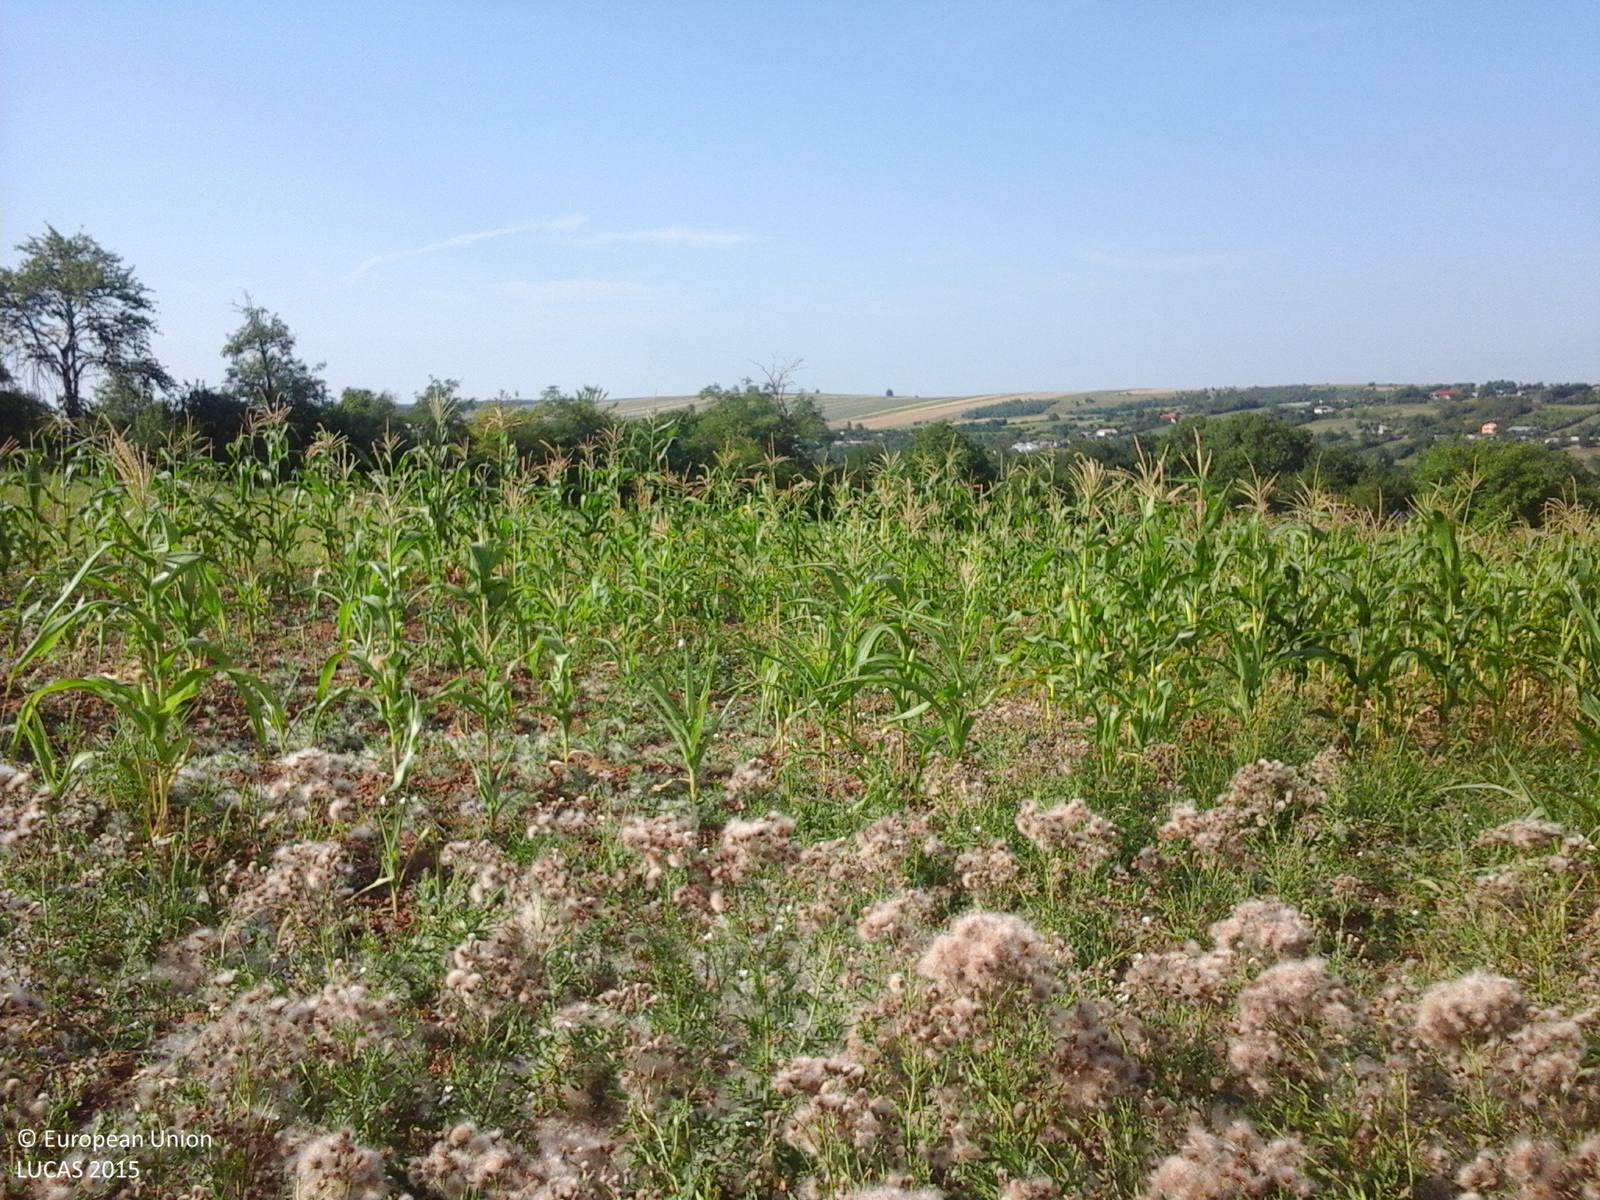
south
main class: Grassland
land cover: Spontaneously vegetated surfaces
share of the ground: > 75 %
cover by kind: herbaceous plants 90 %, unconsolidated bare surface 10 %
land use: Fallow land
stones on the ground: < 10 %
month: July
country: RO
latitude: 46.0785
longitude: 27.7926
